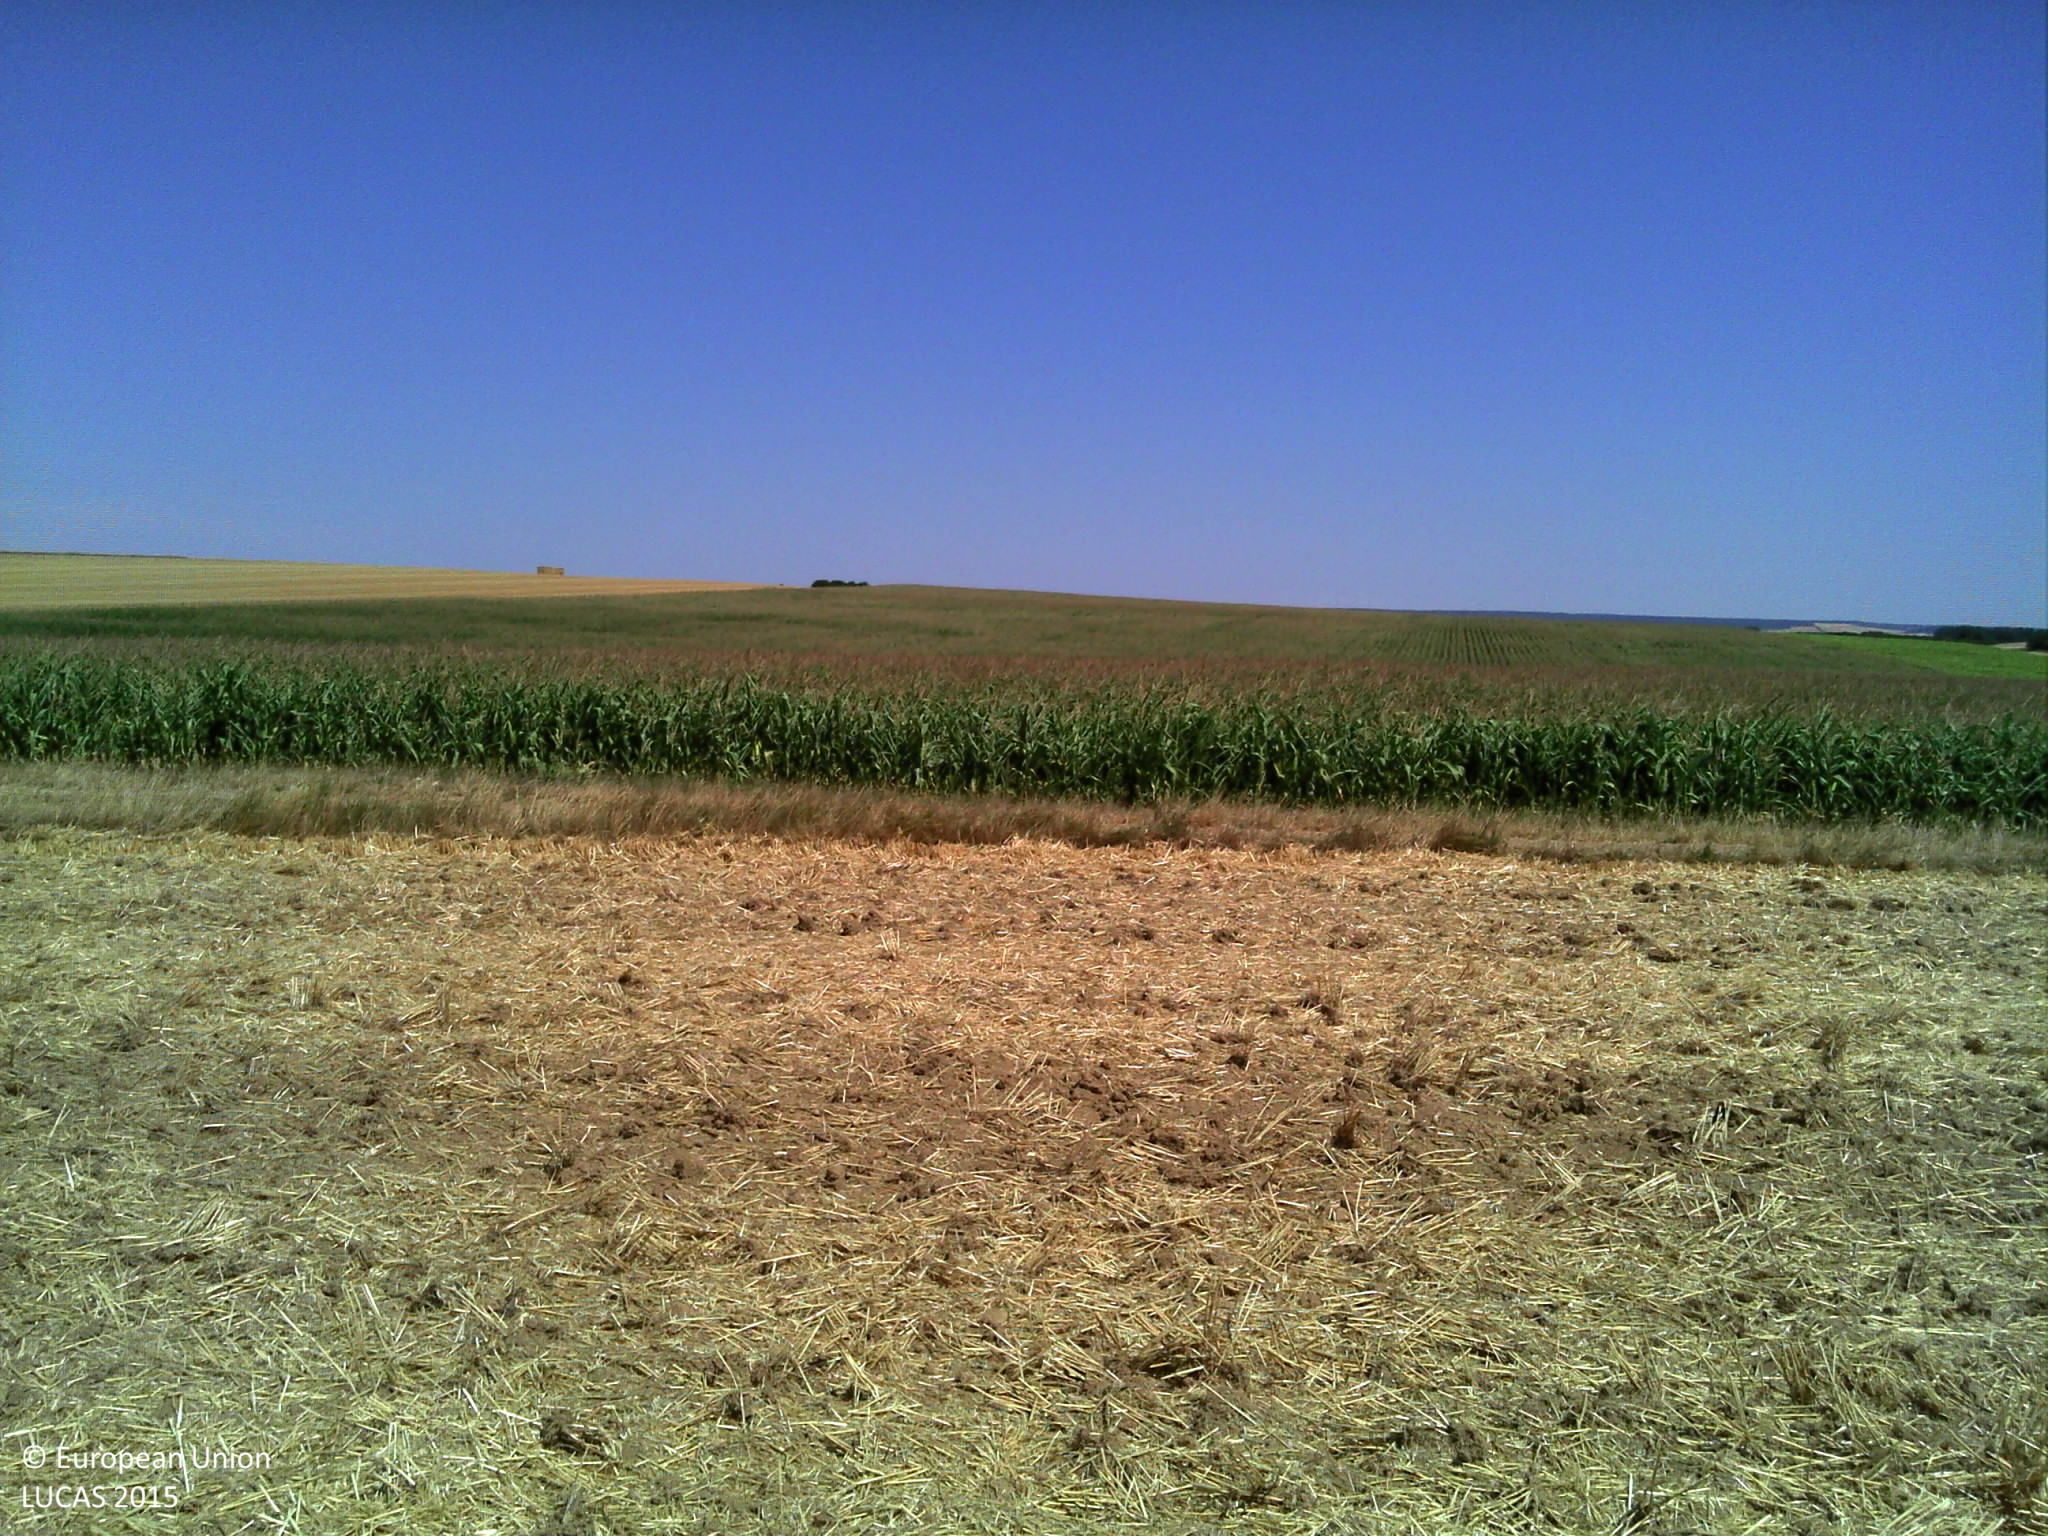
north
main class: Cropland
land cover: Common wheat
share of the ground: > 75 %
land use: Agriculture (excluding fallow land and kitchen gardens)
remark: Tilled/Sowed
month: August
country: FR
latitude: 47.9189
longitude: 3.4245
